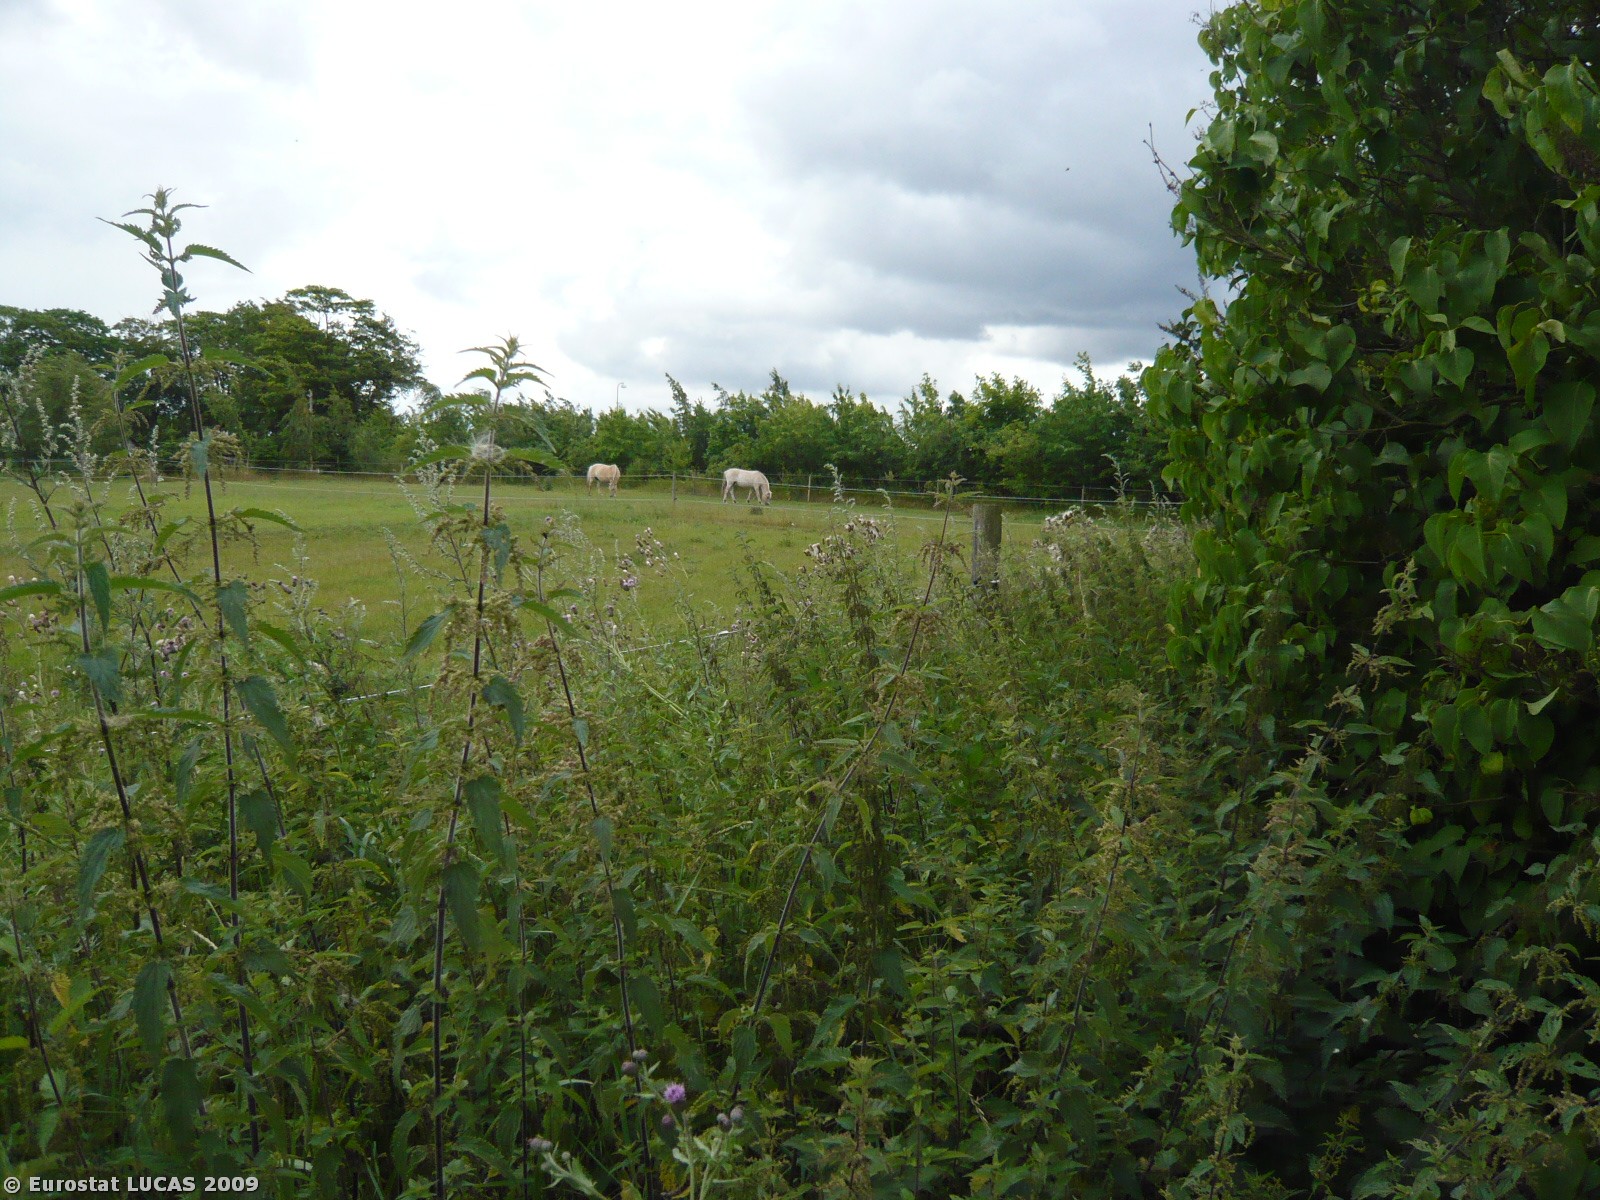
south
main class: Grassland
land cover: Grassland without tree/shrub cover
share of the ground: > 75 %
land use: Agriculture (excluding fallow land and kitchen gardens)
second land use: Amenities, museums, leisure
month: July
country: DK
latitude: 55.5607
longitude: 12.0119
